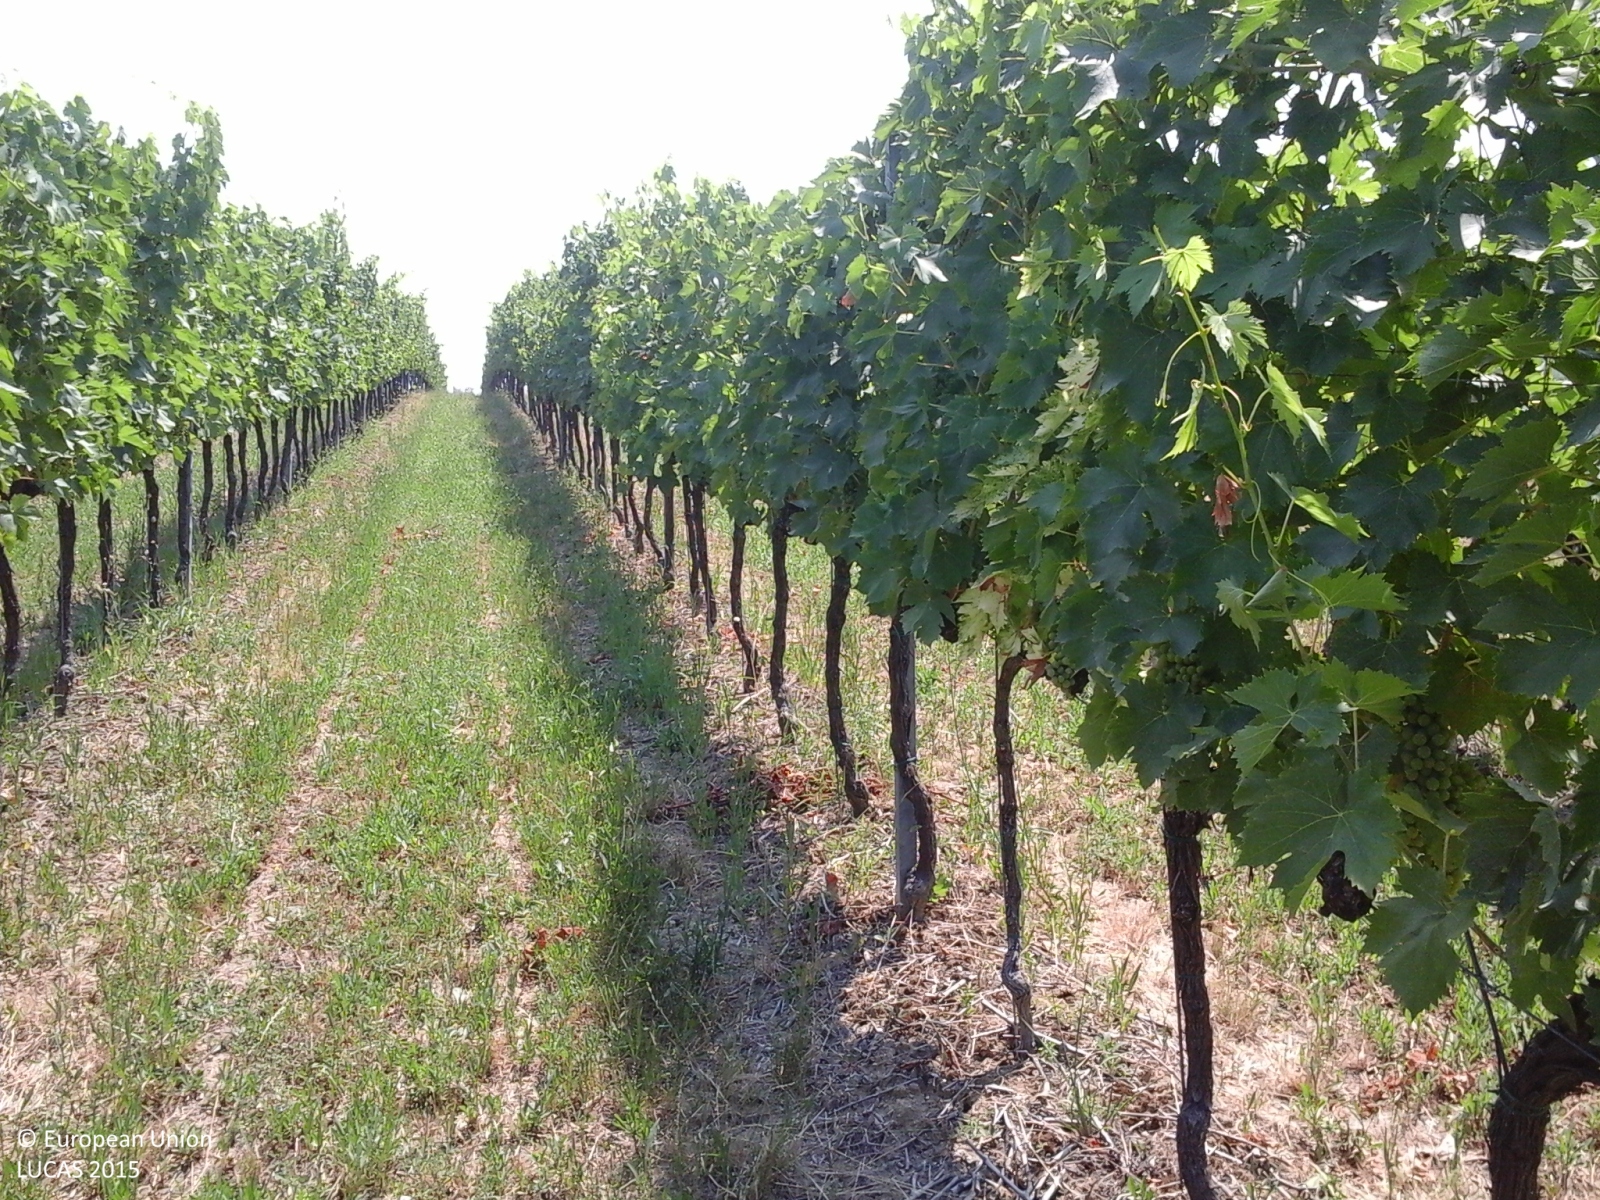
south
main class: Cropland
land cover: Vineyards
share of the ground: > 75 %
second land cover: Grassland without tree/shrub cover
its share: > 75 %
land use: Agriculture (excluding fallow land and kitchen gardens)
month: July
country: IT
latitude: 44.0707
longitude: 12.3793
